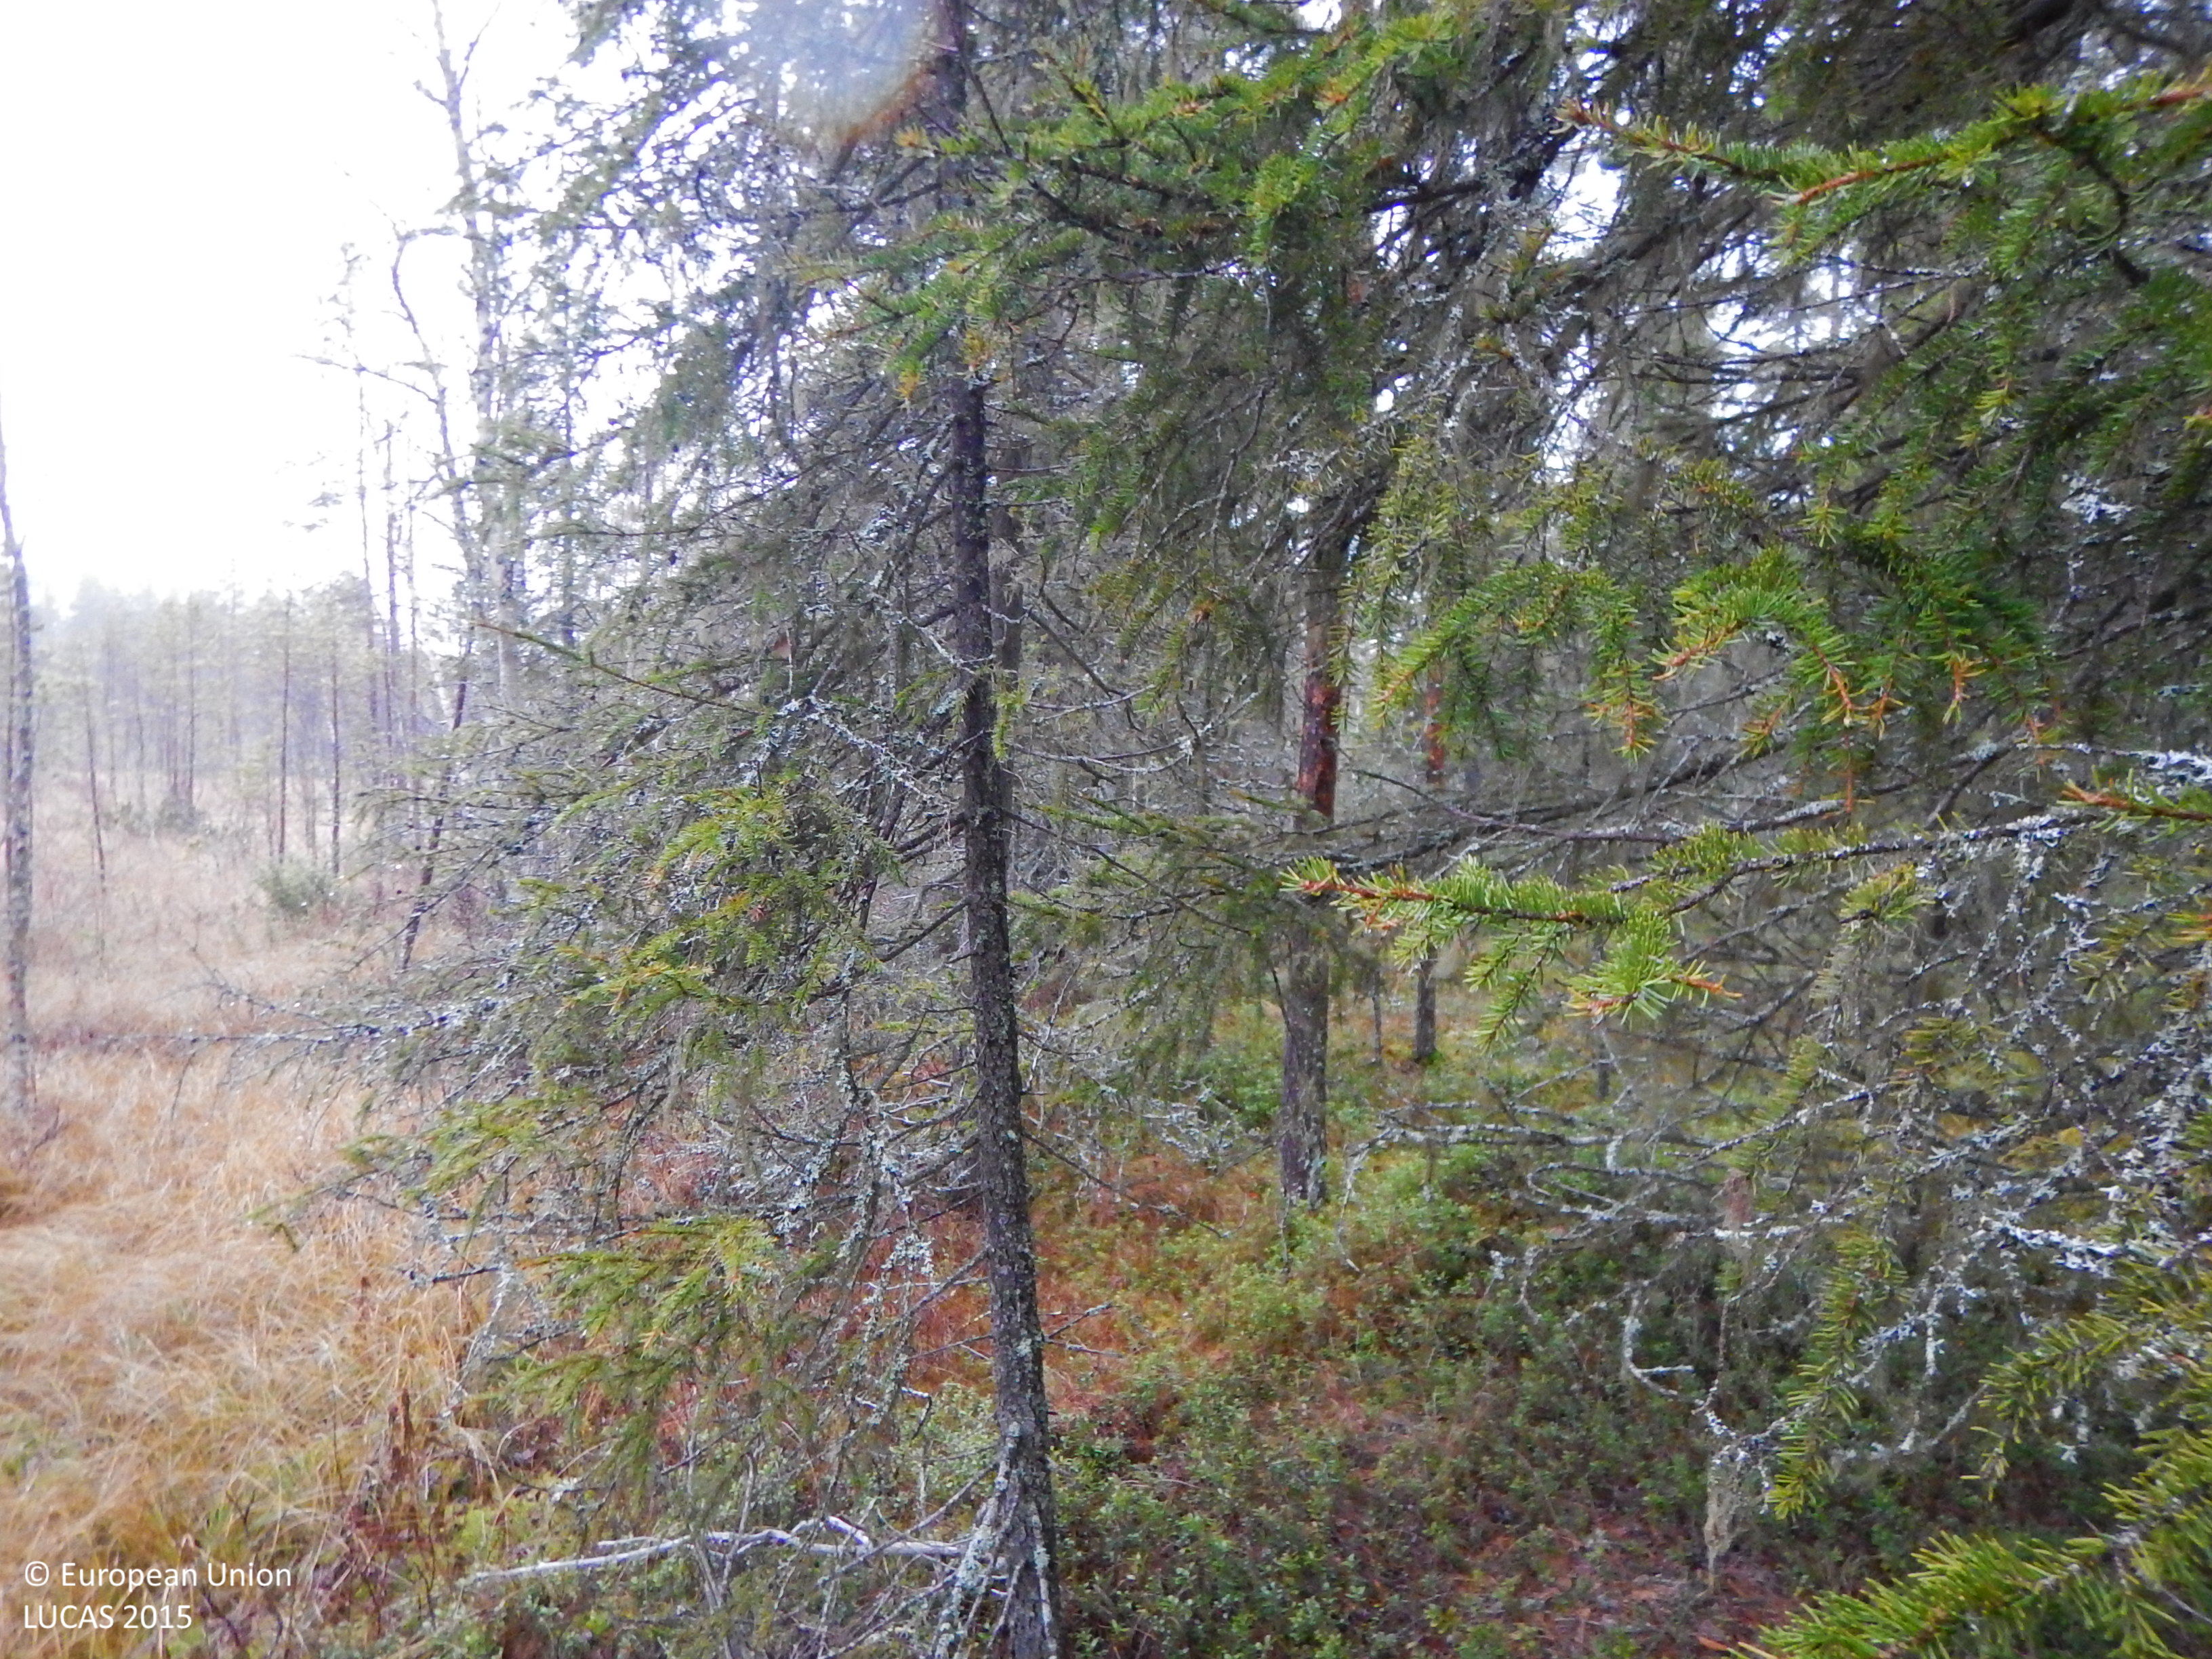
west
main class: Woodland
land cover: Other mixed woodland
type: boreal forest
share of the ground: 50 - 75 %
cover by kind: coniferous forest trees 40 %, lichens and mosses 20 %, broadleaved forest trees 15 %, shrubs 15 %, herbaceous plants 10 %
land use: Forestry
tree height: > 5 m
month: November
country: SE
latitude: 65.1073
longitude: 20.5108
